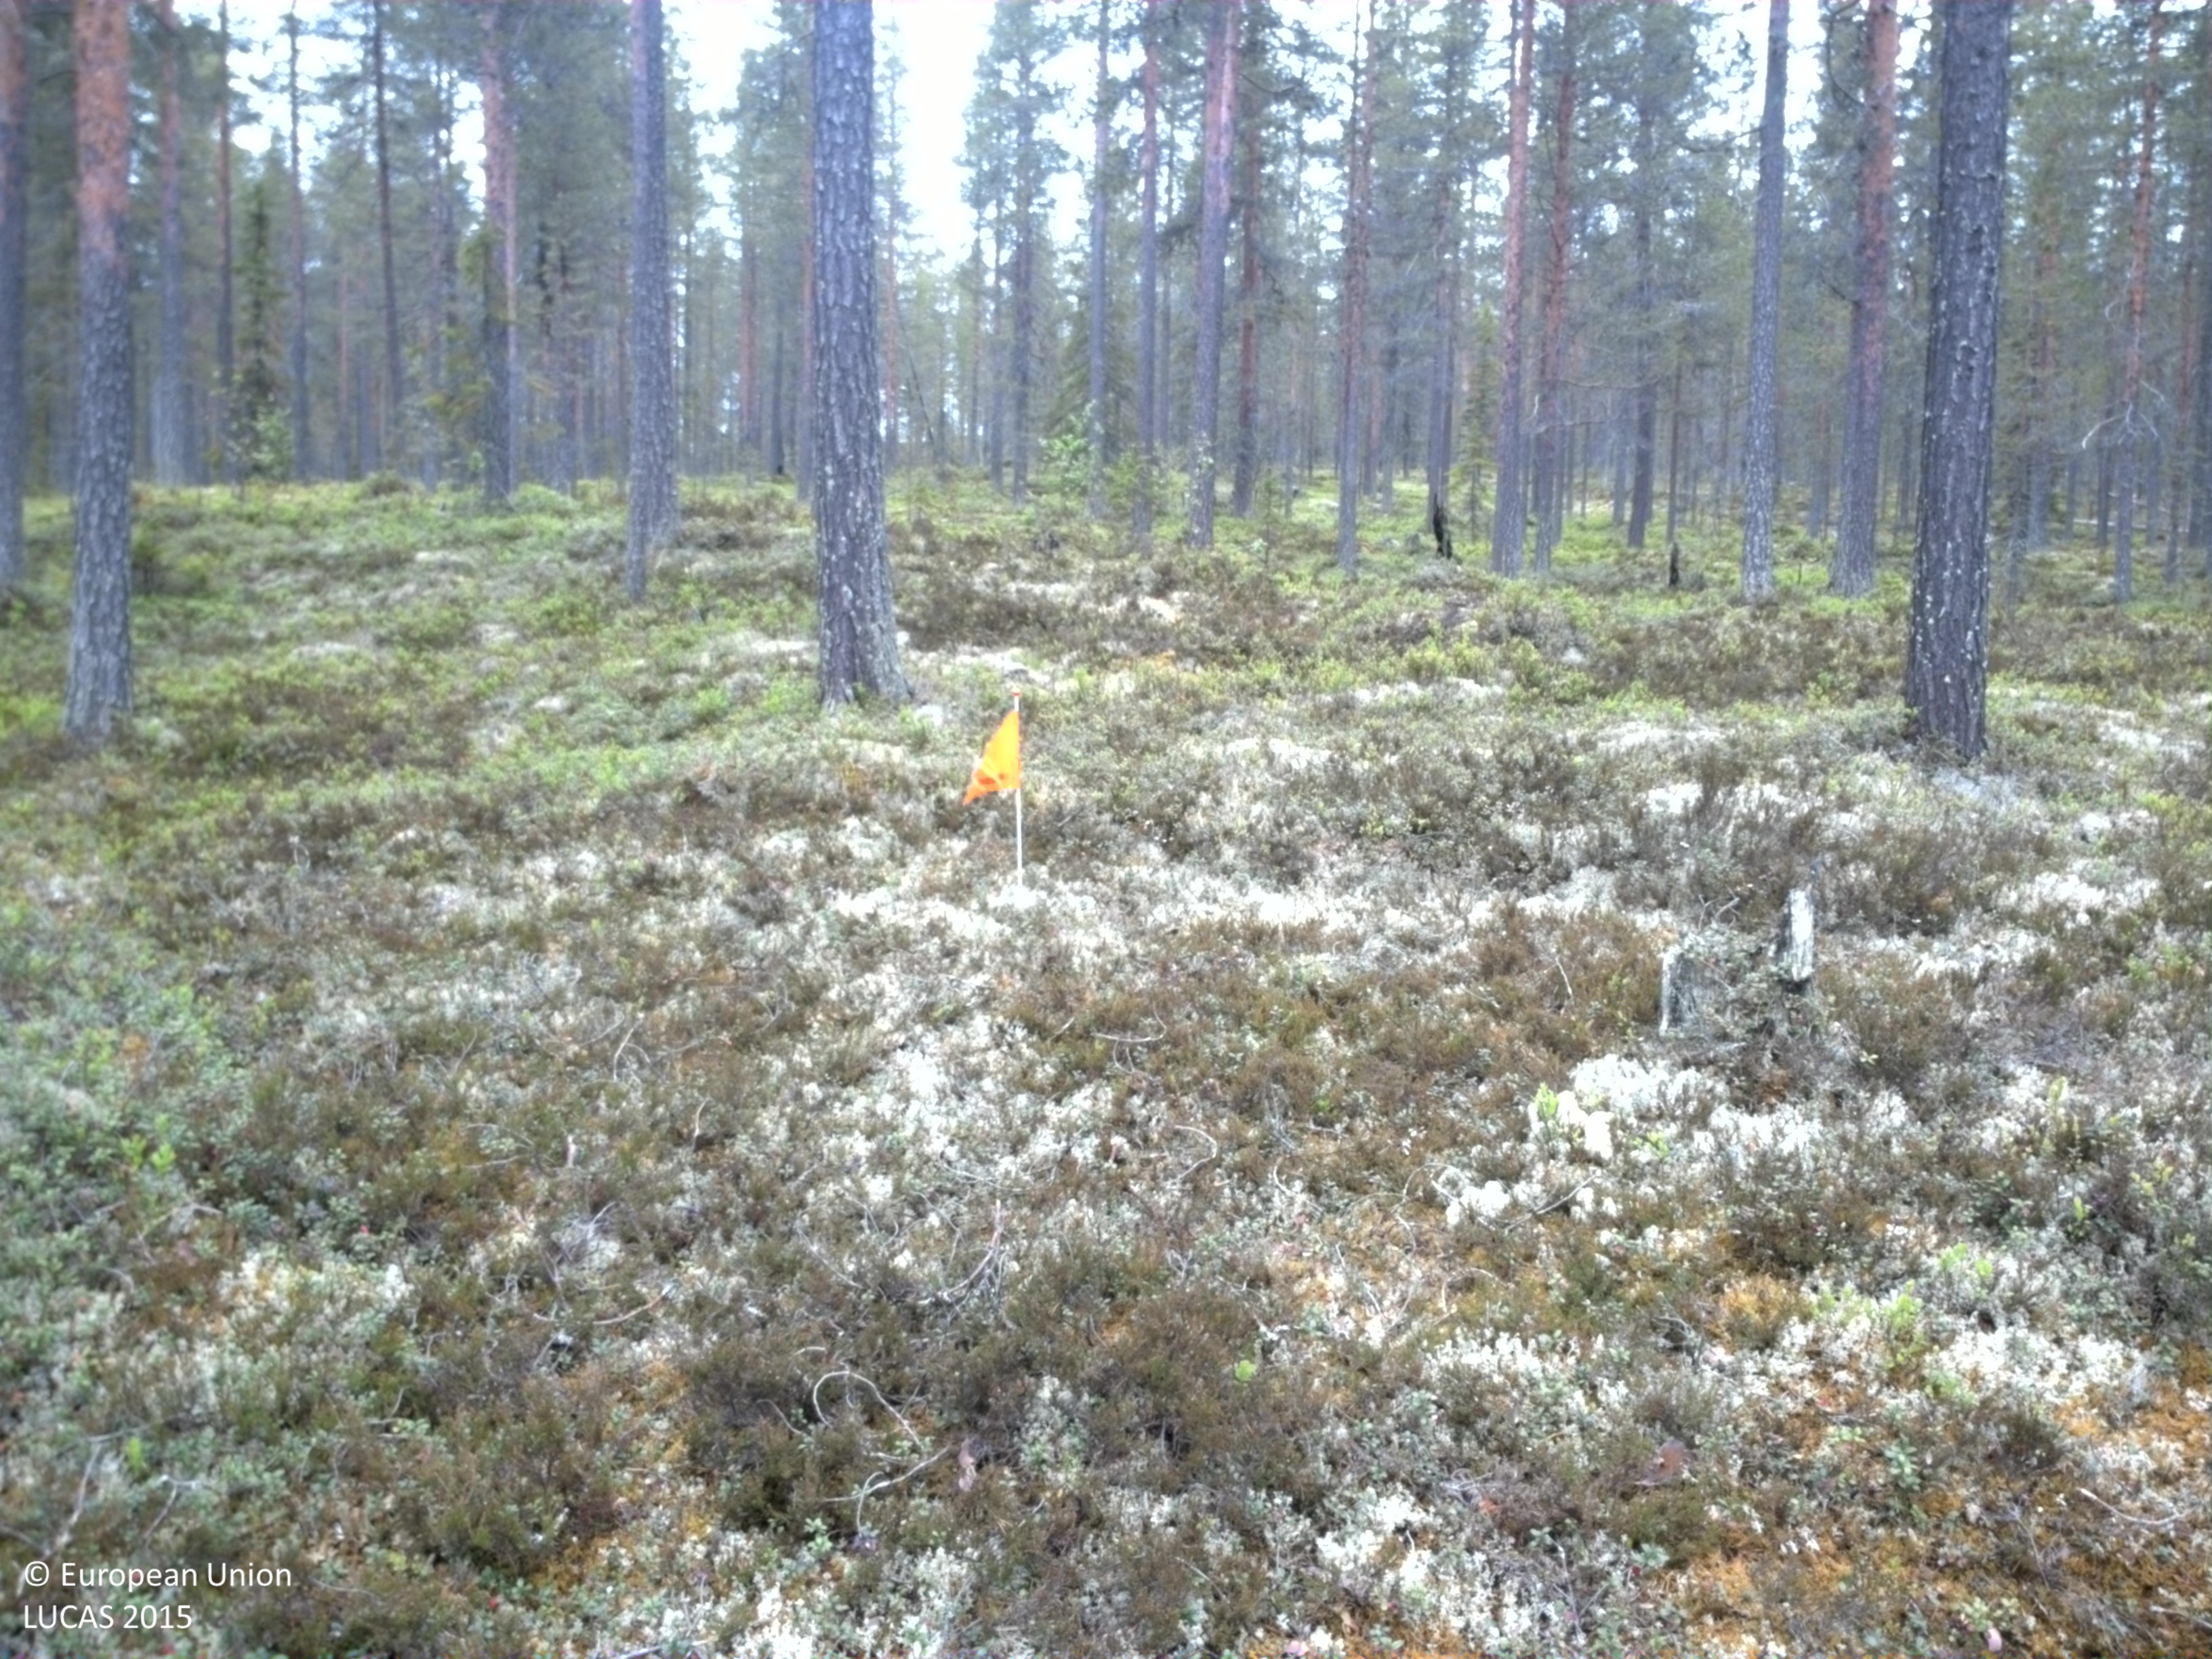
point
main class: Woodland
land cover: Pine dominated coniferous woodland
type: boreal forest
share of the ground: 50 - 75 %
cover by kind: coniferous forest trees 60 %, lichens and mosses 25 %, herbaceous plants 15 %
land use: Forestry
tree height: > 5 m
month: June
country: SE
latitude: 61.4496
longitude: 13.6446
